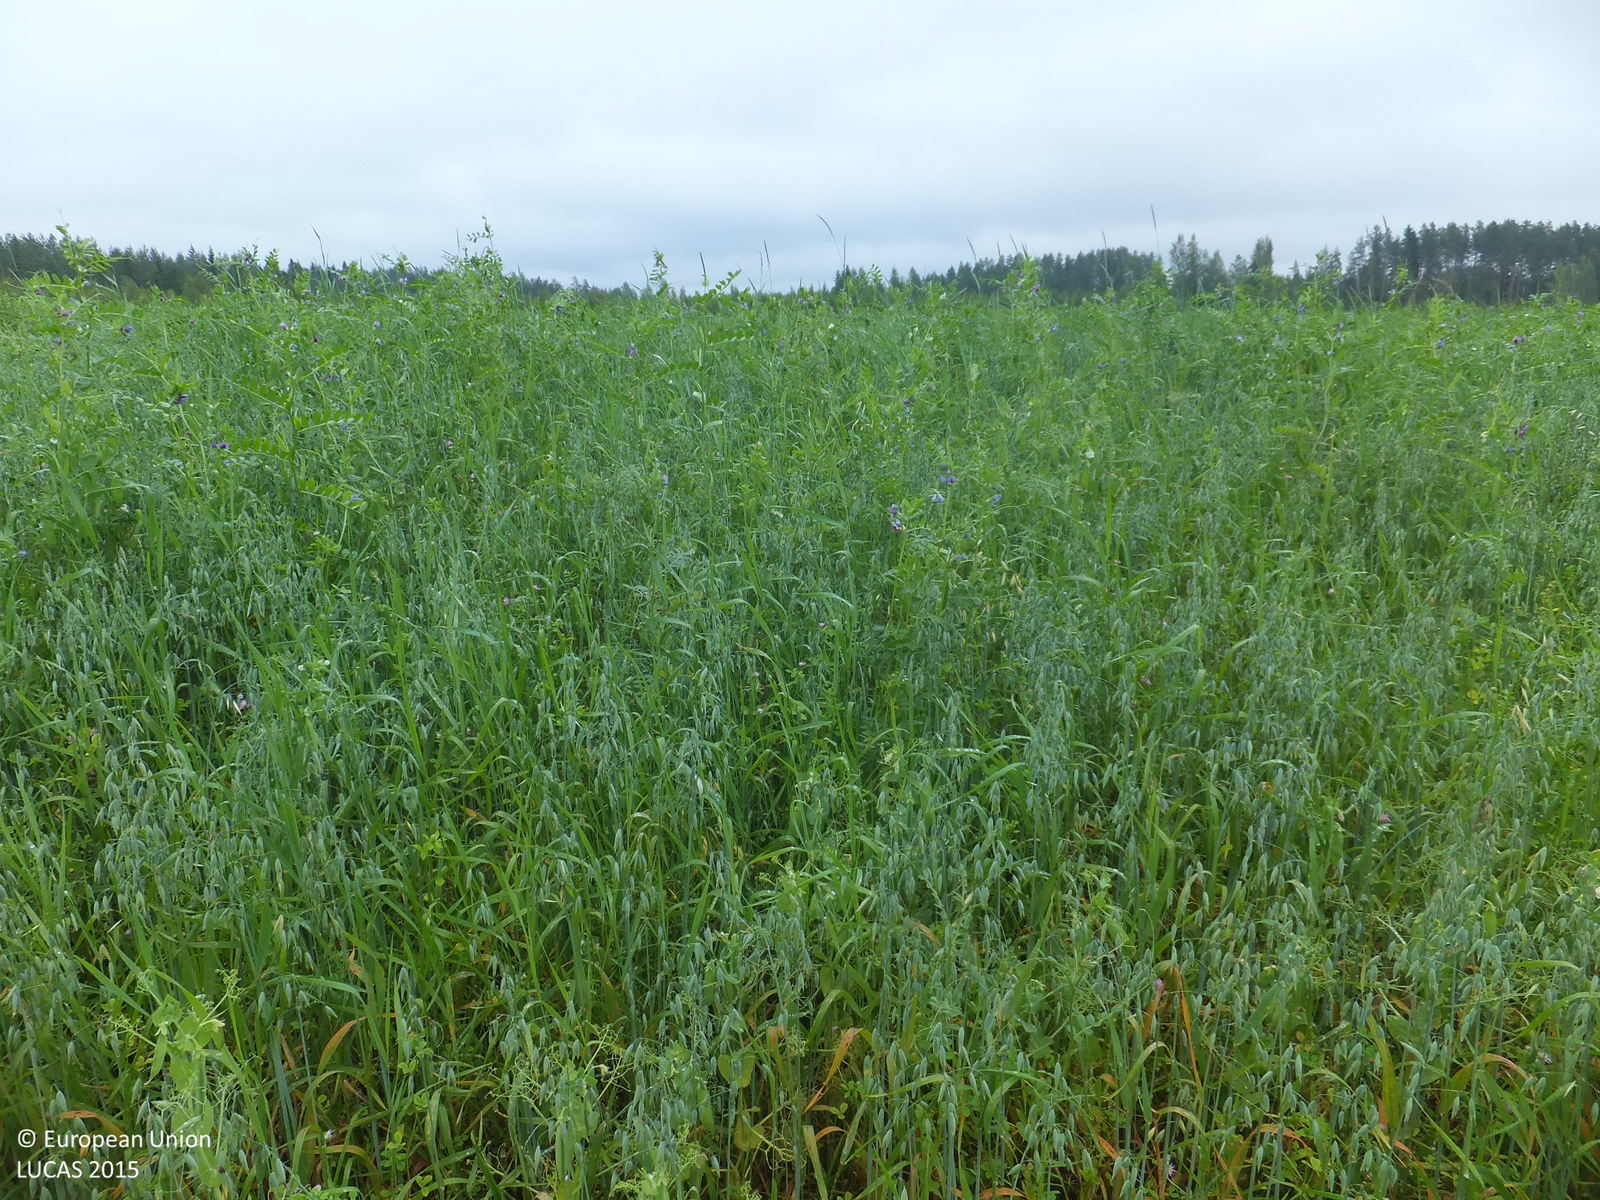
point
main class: Cropland
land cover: Oats
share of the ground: 50 - 75 %
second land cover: Clovers
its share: 25 - 50 %
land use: Agriculture (excluding fallow land and kitchen gardens)
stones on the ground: < 10 %
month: August
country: FI
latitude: 63.3098
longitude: 23.0071
